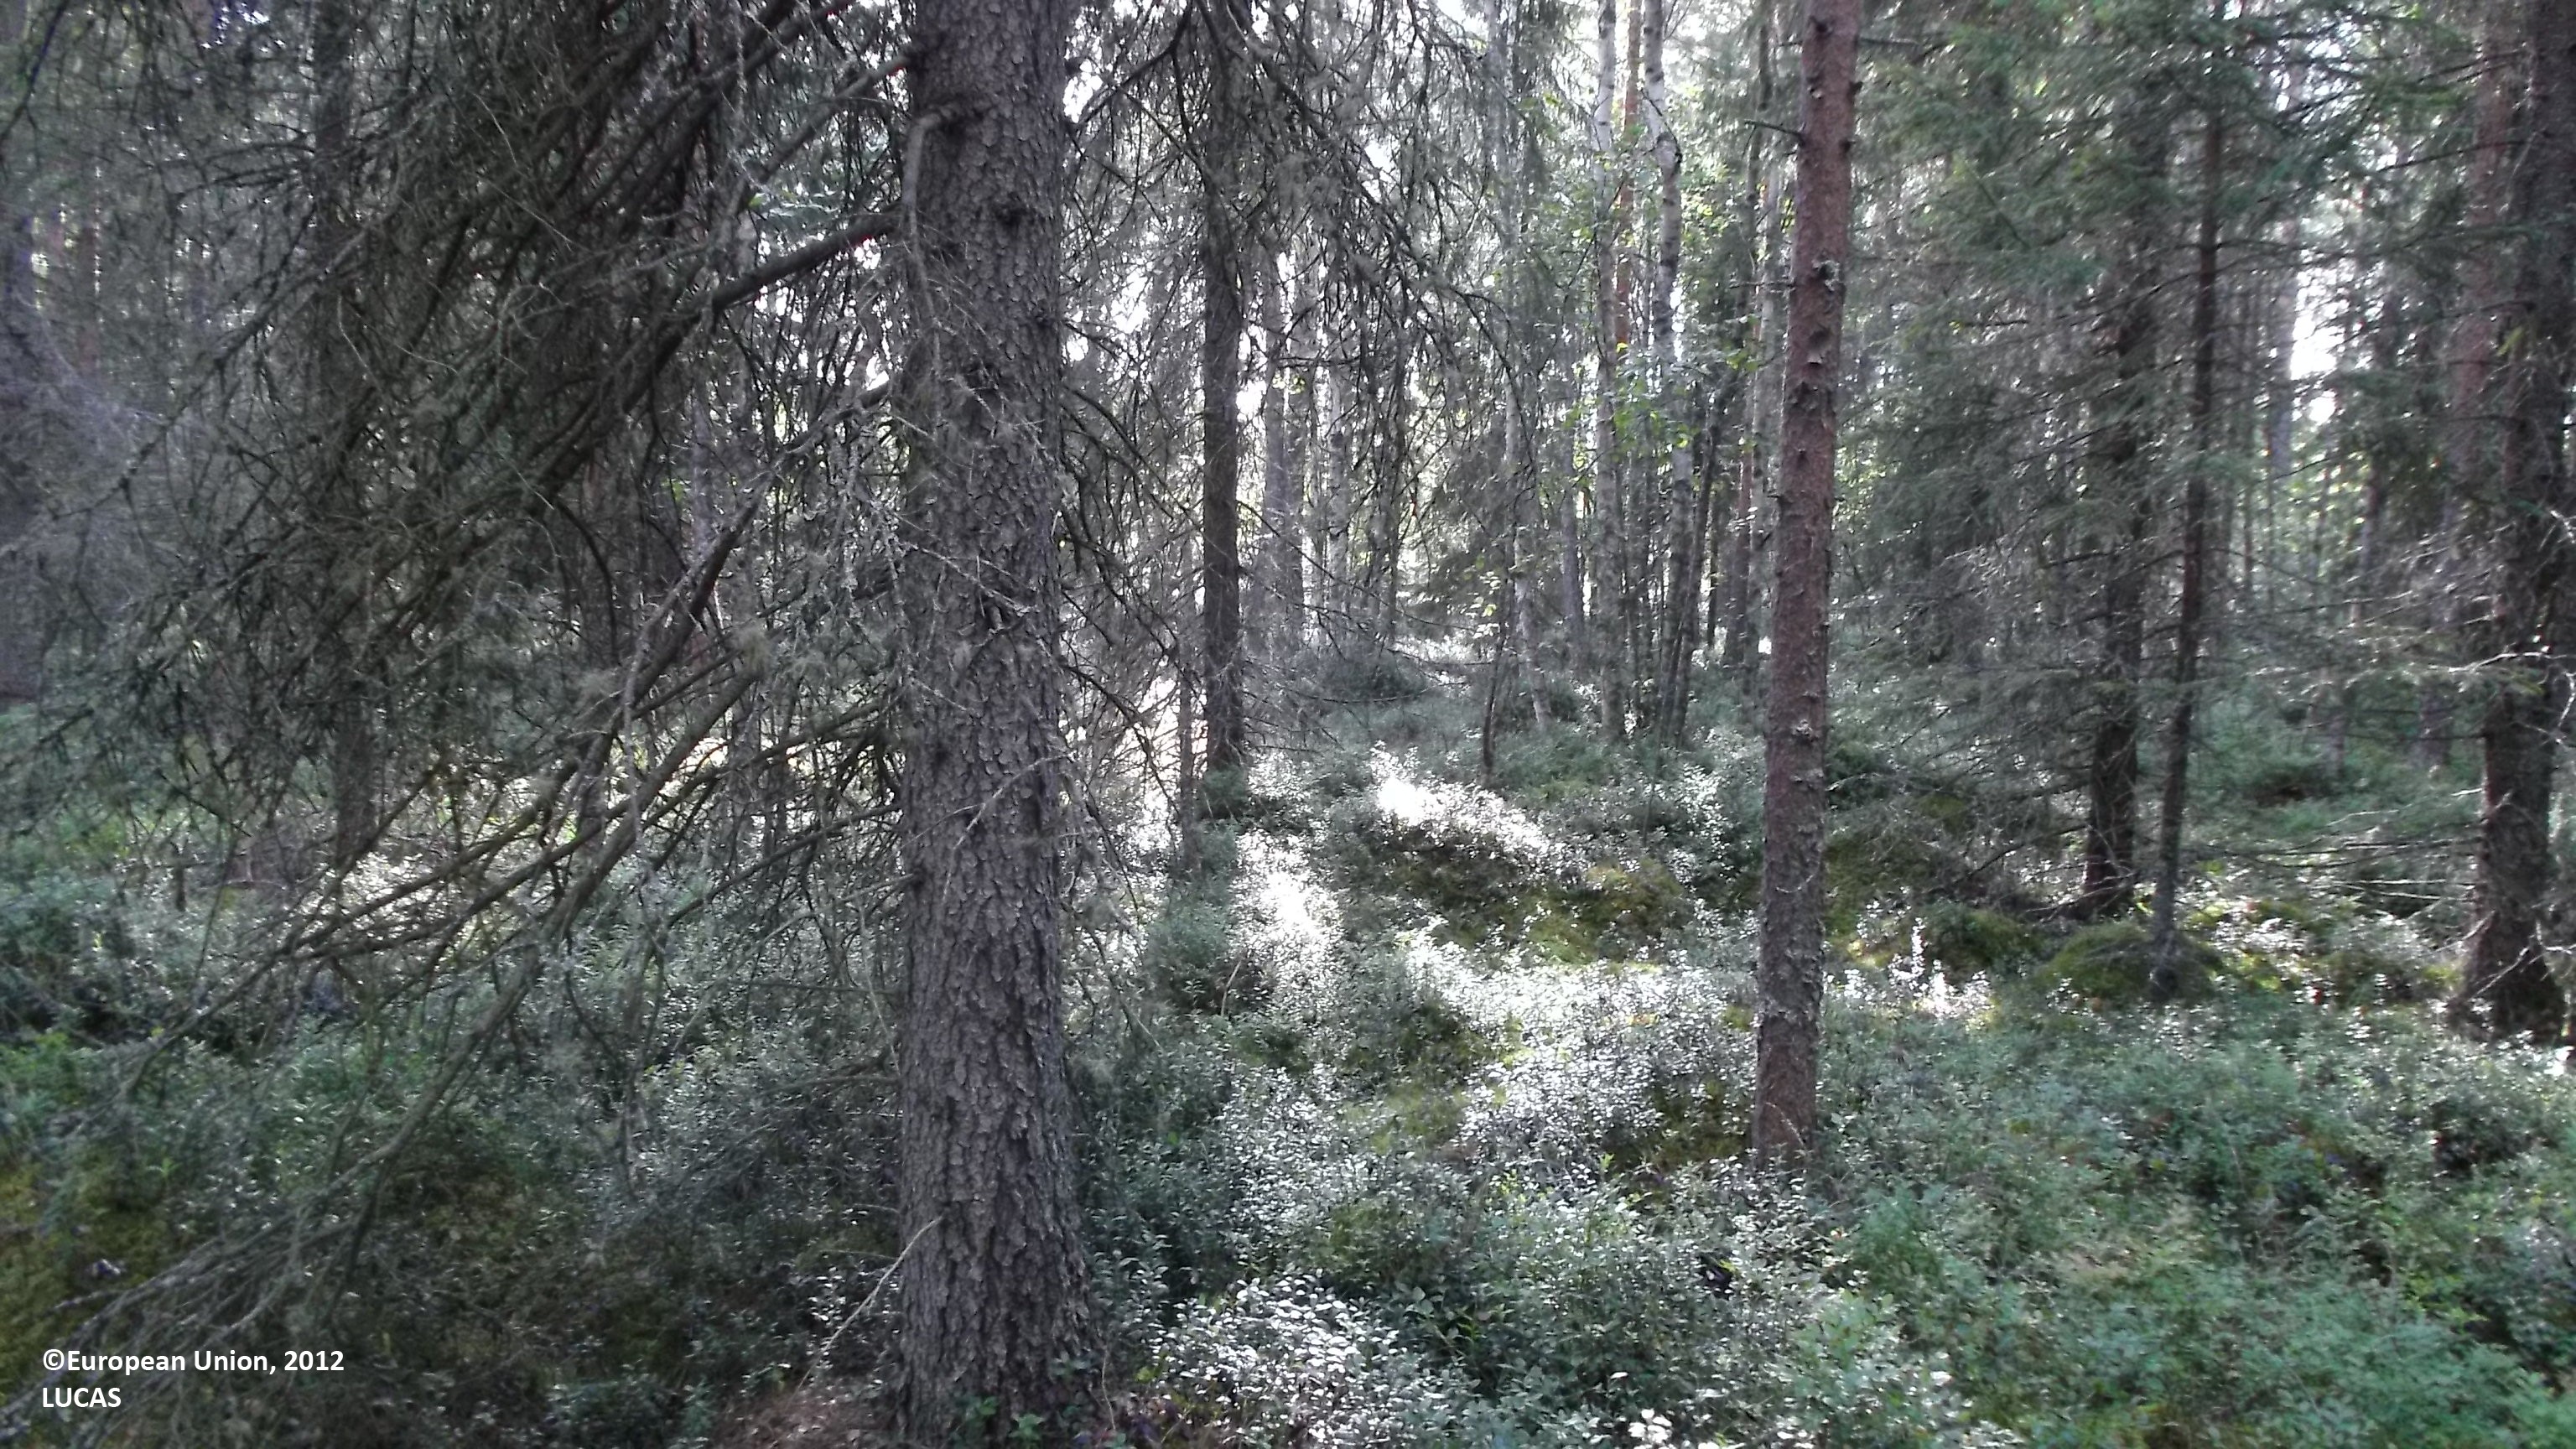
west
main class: Woodland
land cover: Other mixed woodland
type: boreal forest
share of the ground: 50 - 75 %
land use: Forestry
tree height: > 5 m
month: August
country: FI
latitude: 63.9499
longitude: 23.6733
